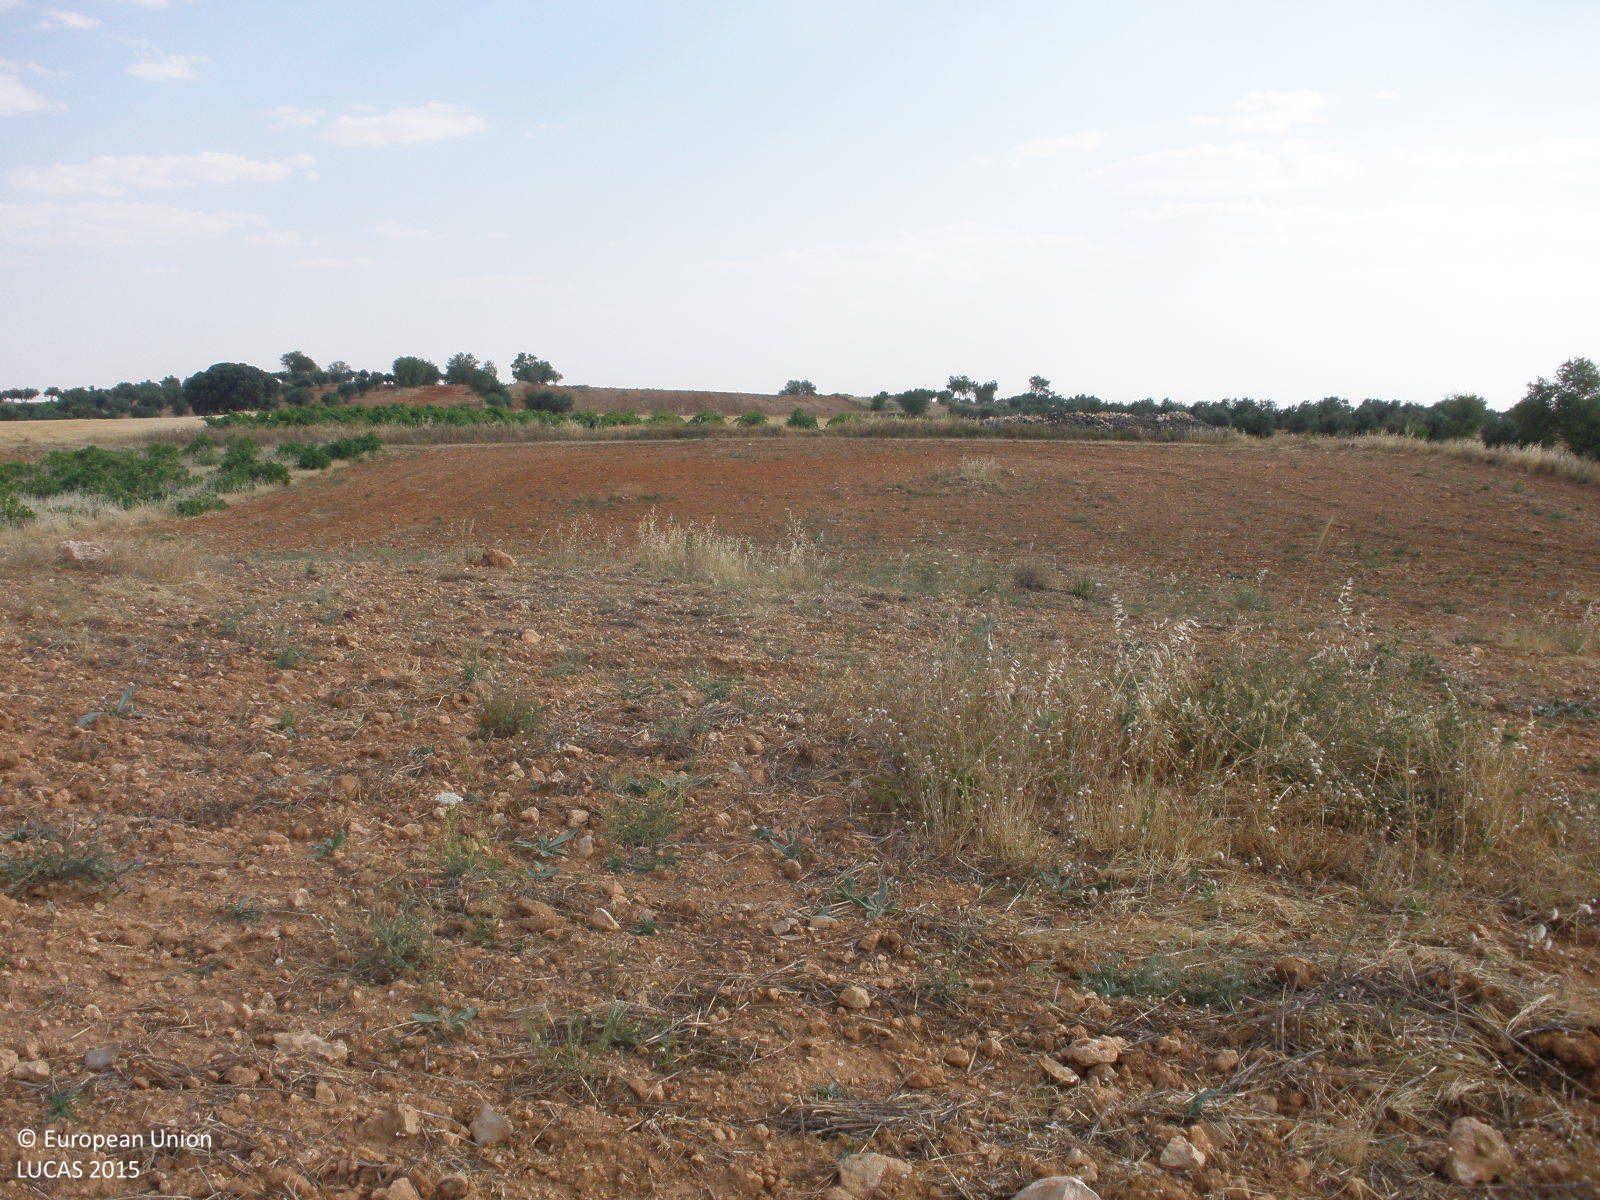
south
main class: Grassland
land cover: Spontaneously vegetated surfaces
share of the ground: 10 - 25 %
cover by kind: unconsolidated bare surface 80 %, herbaceous plants 20 %
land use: Fallow land
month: June
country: ES
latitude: 40.1472
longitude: -3.2815
